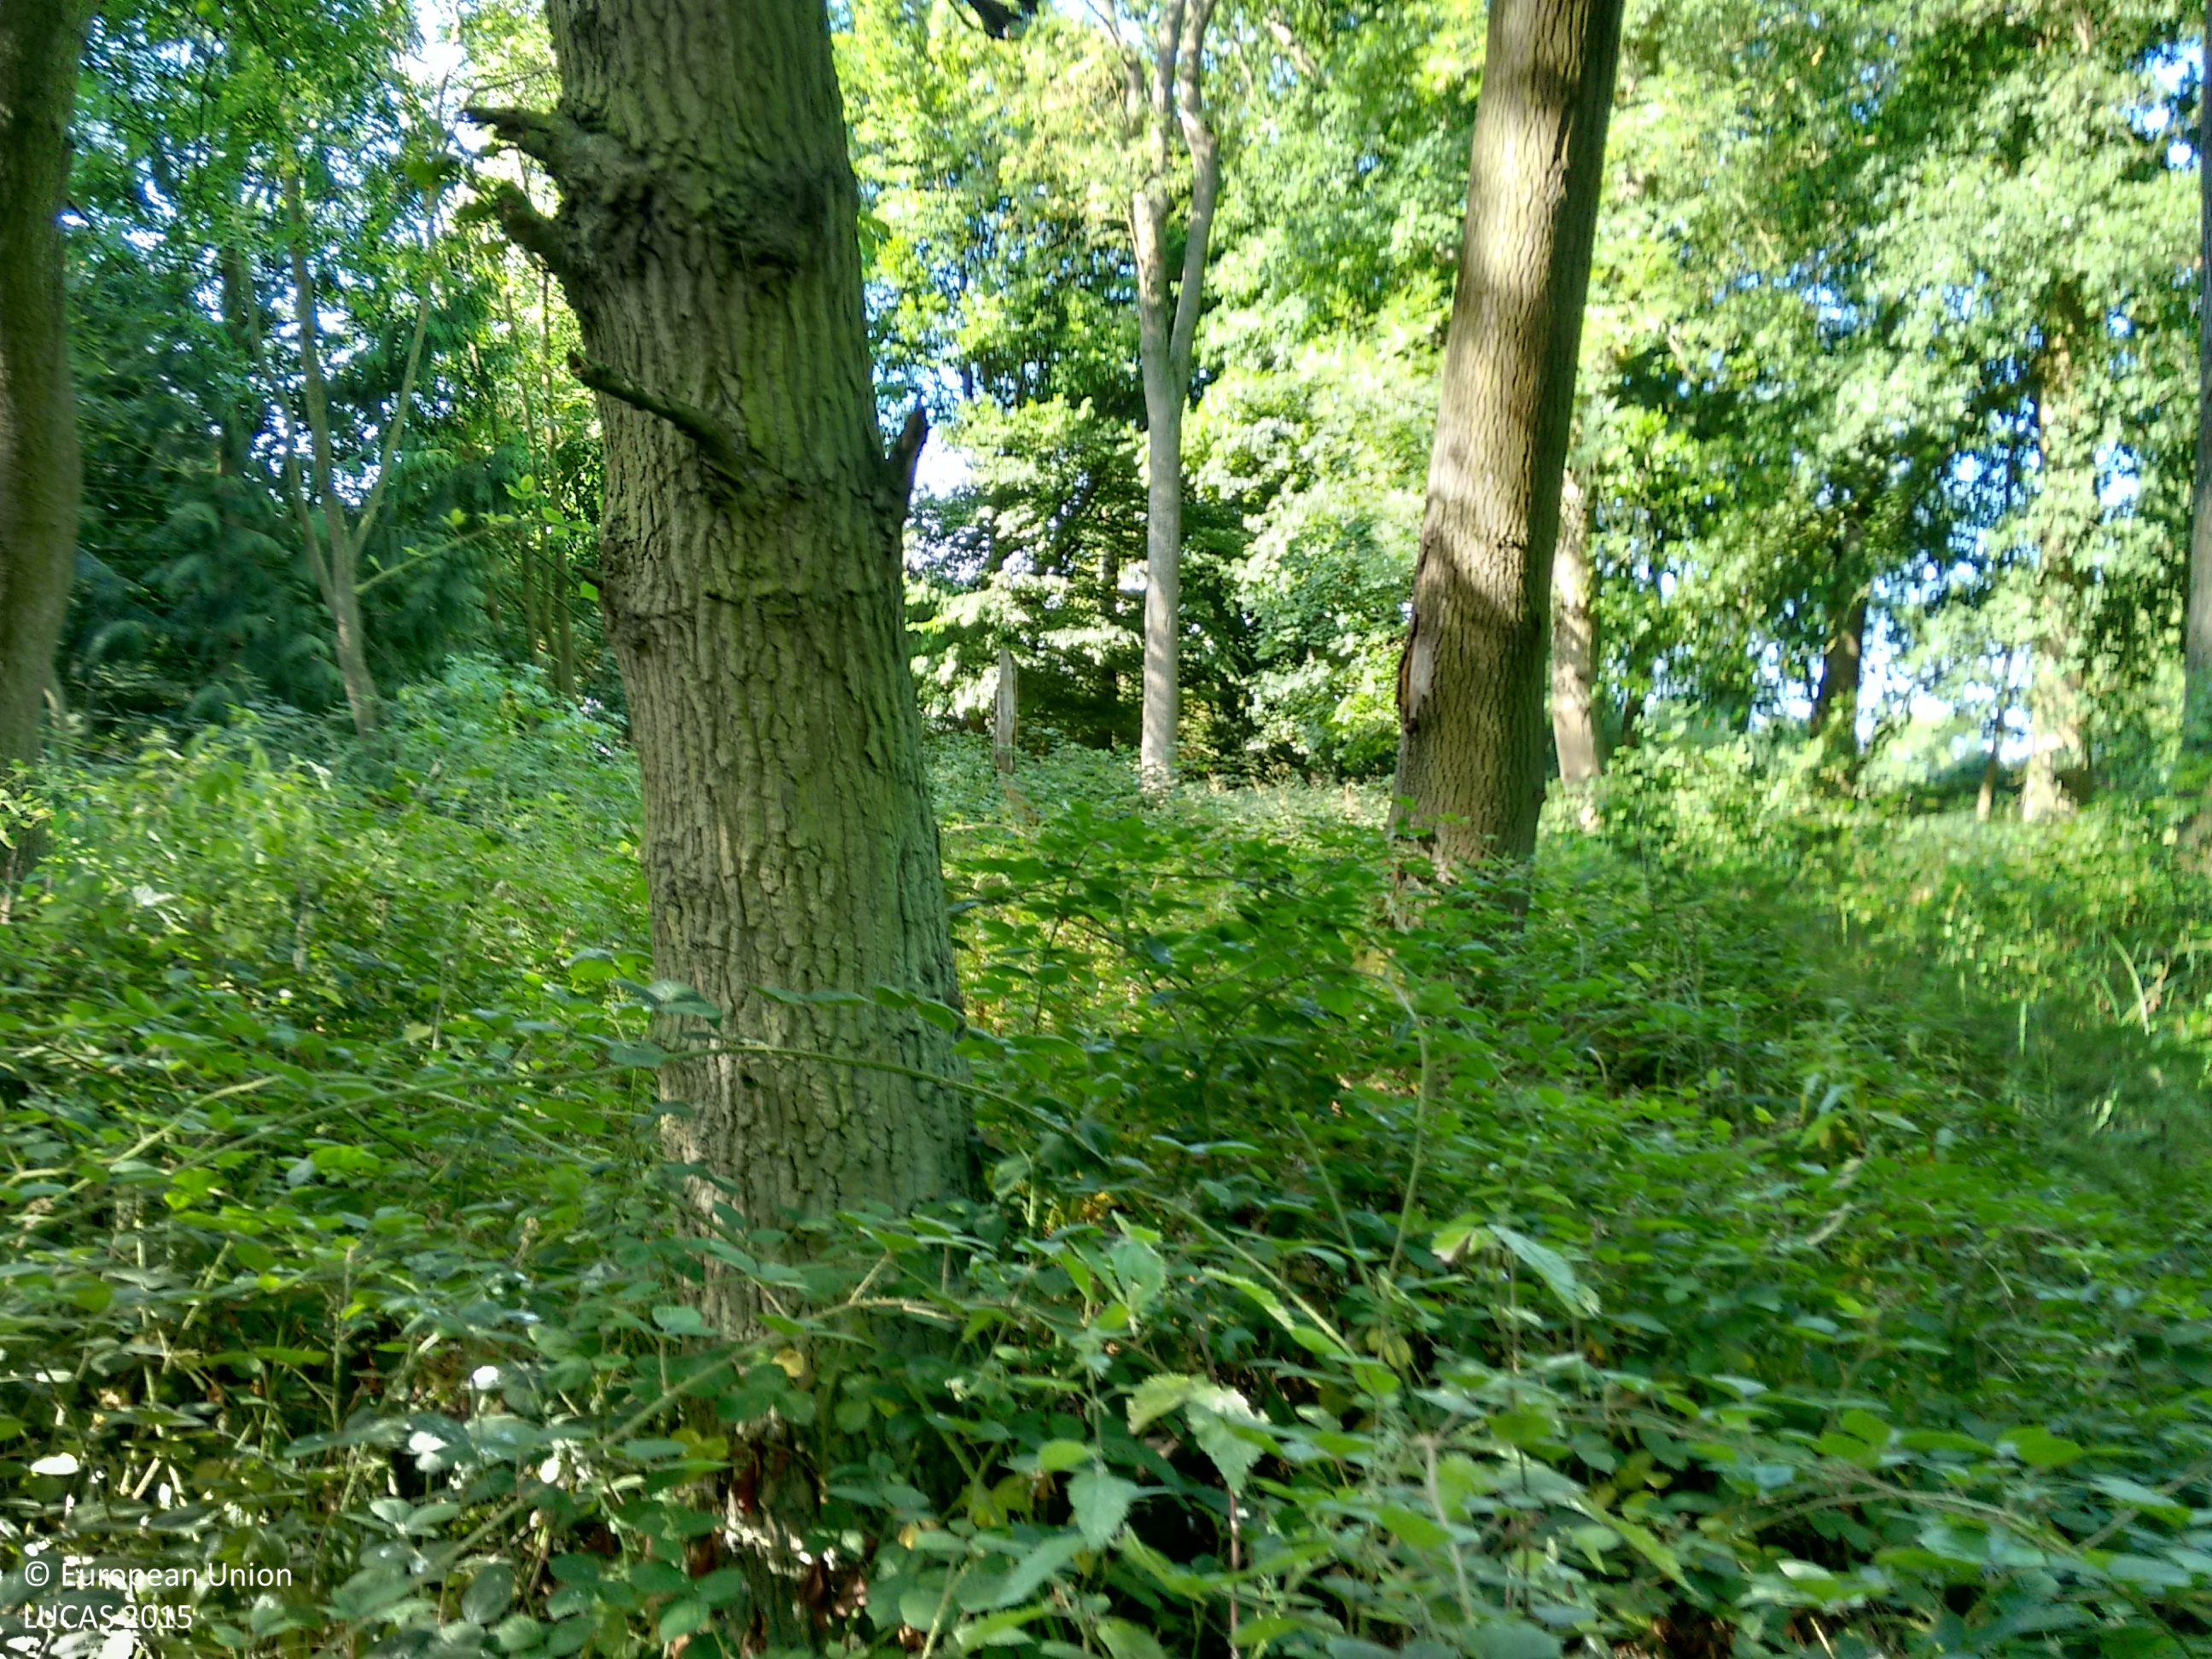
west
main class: Woodland
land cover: Broadleaved woodland
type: mesophytic deciduous forest
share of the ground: > 75 %
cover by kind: broadleaved forest trees 80 %, shrubs 20 %
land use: Forestry
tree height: > 5 m
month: August
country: GB
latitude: 52.1664
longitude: -0.8764
